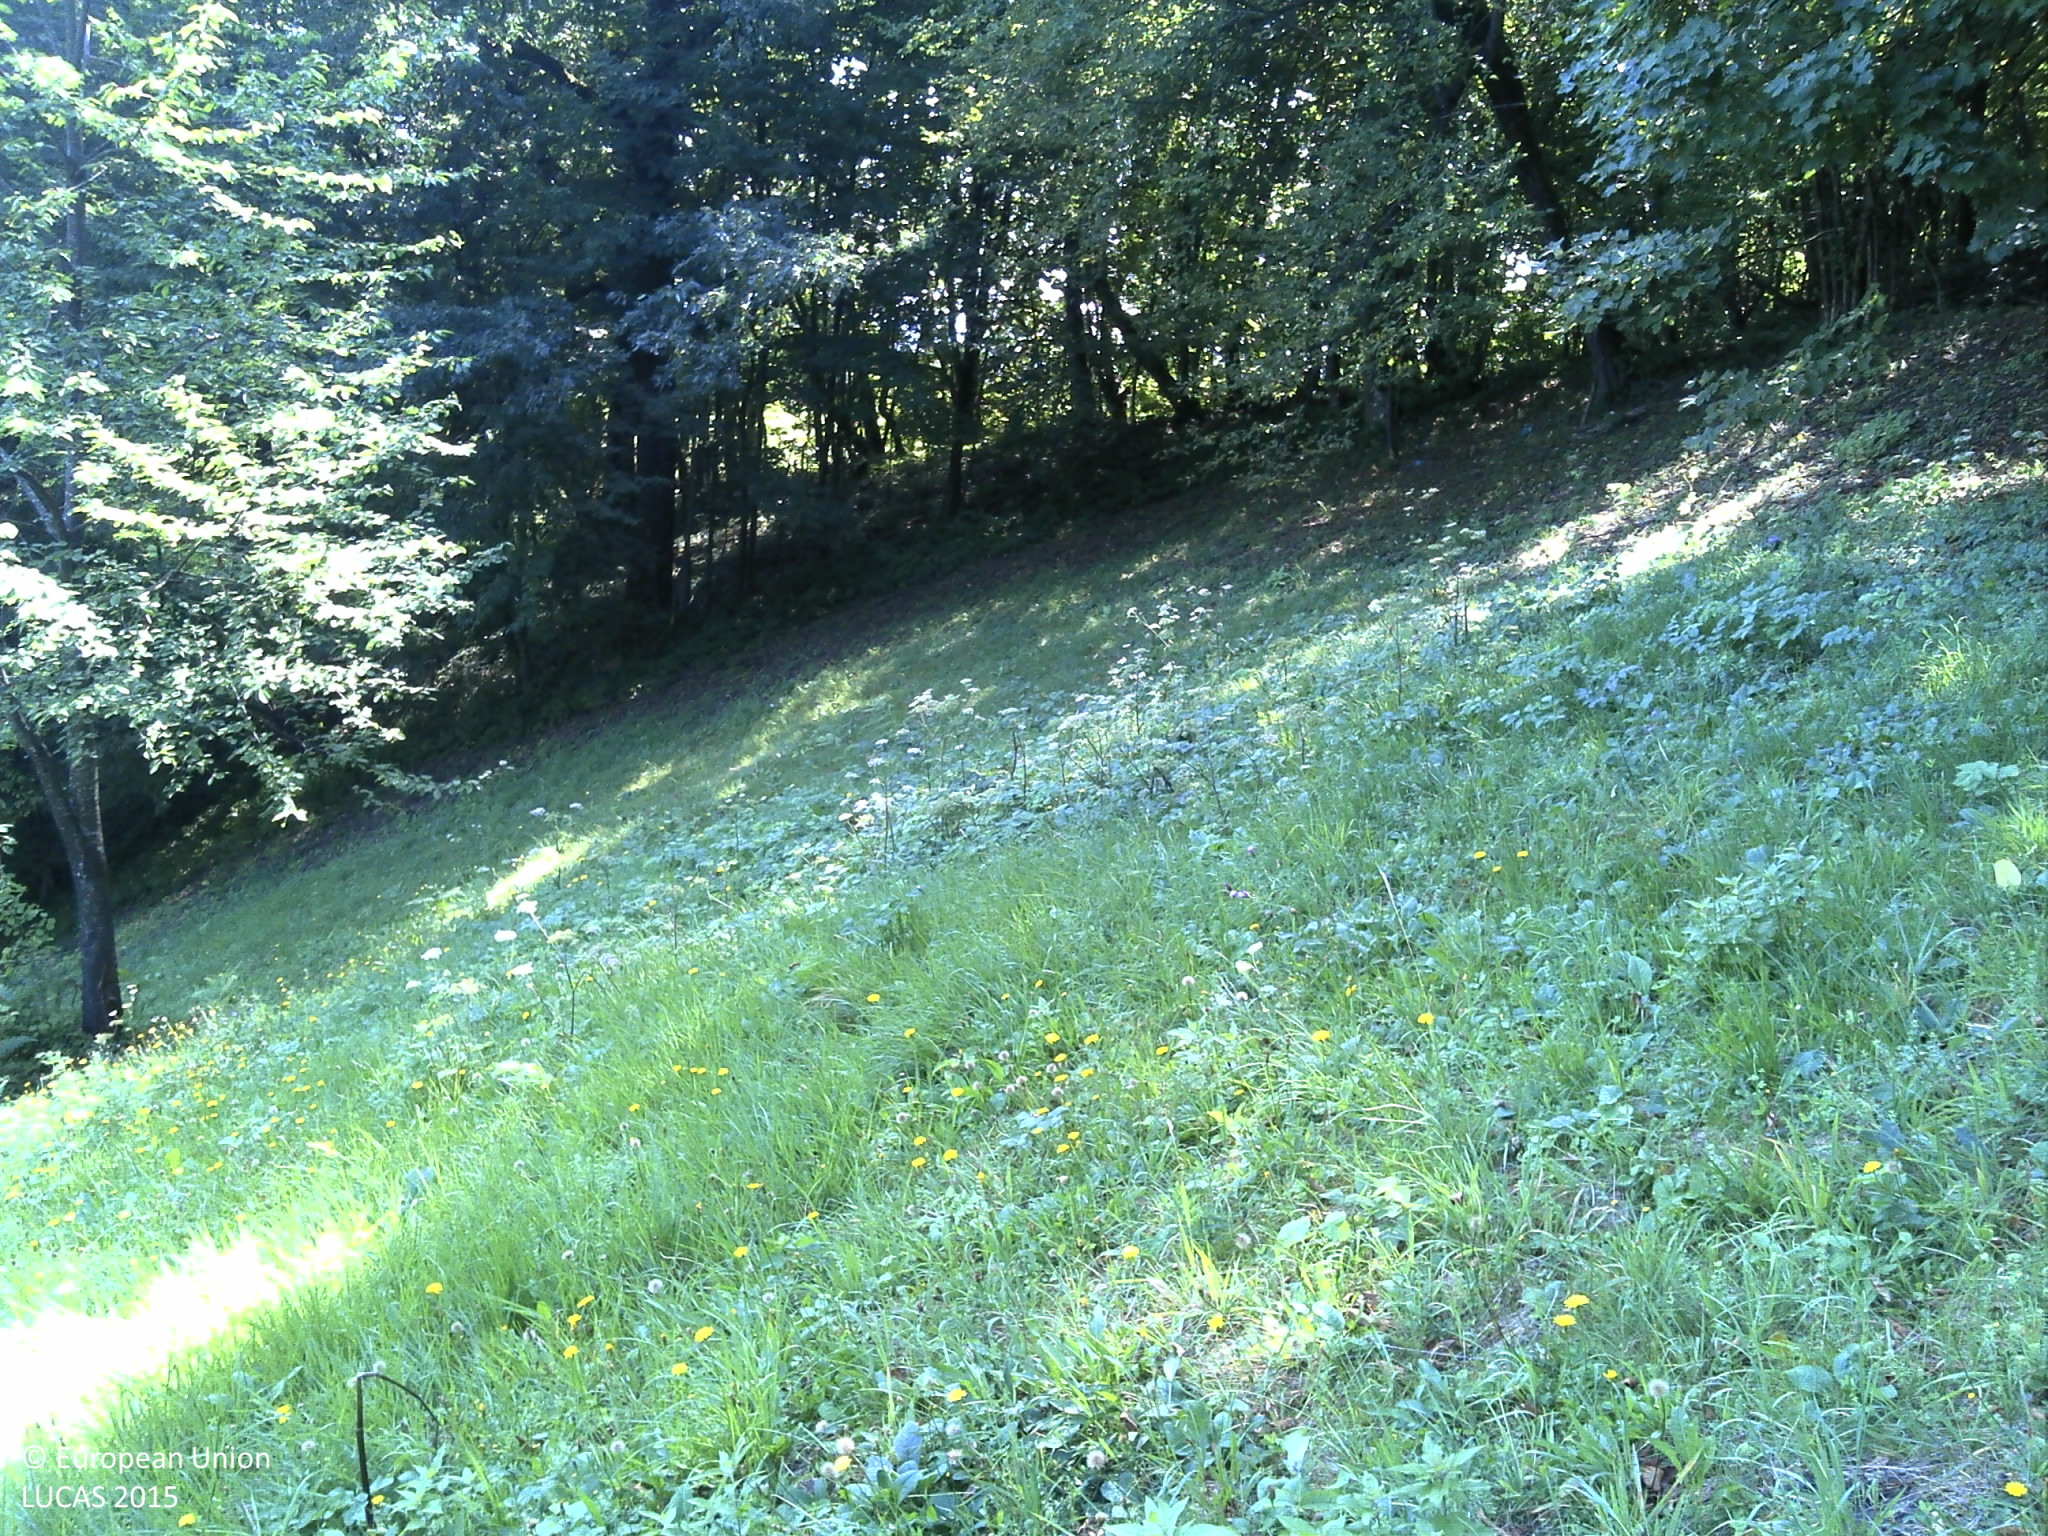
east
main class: Grassland
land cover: Spontaneously vegetated surfaces
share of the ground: > 75 %
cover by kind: herbaceous plants 100 %
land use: Fallow land
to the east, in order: Spontaneously vegetated surfaces; Broadleaved woodland; Spontaneously vegetated surfaces; Broadleaved woodland; Artificial constructions in urban areas
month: August
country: HR
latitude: 45.2111
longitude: 15.2538
